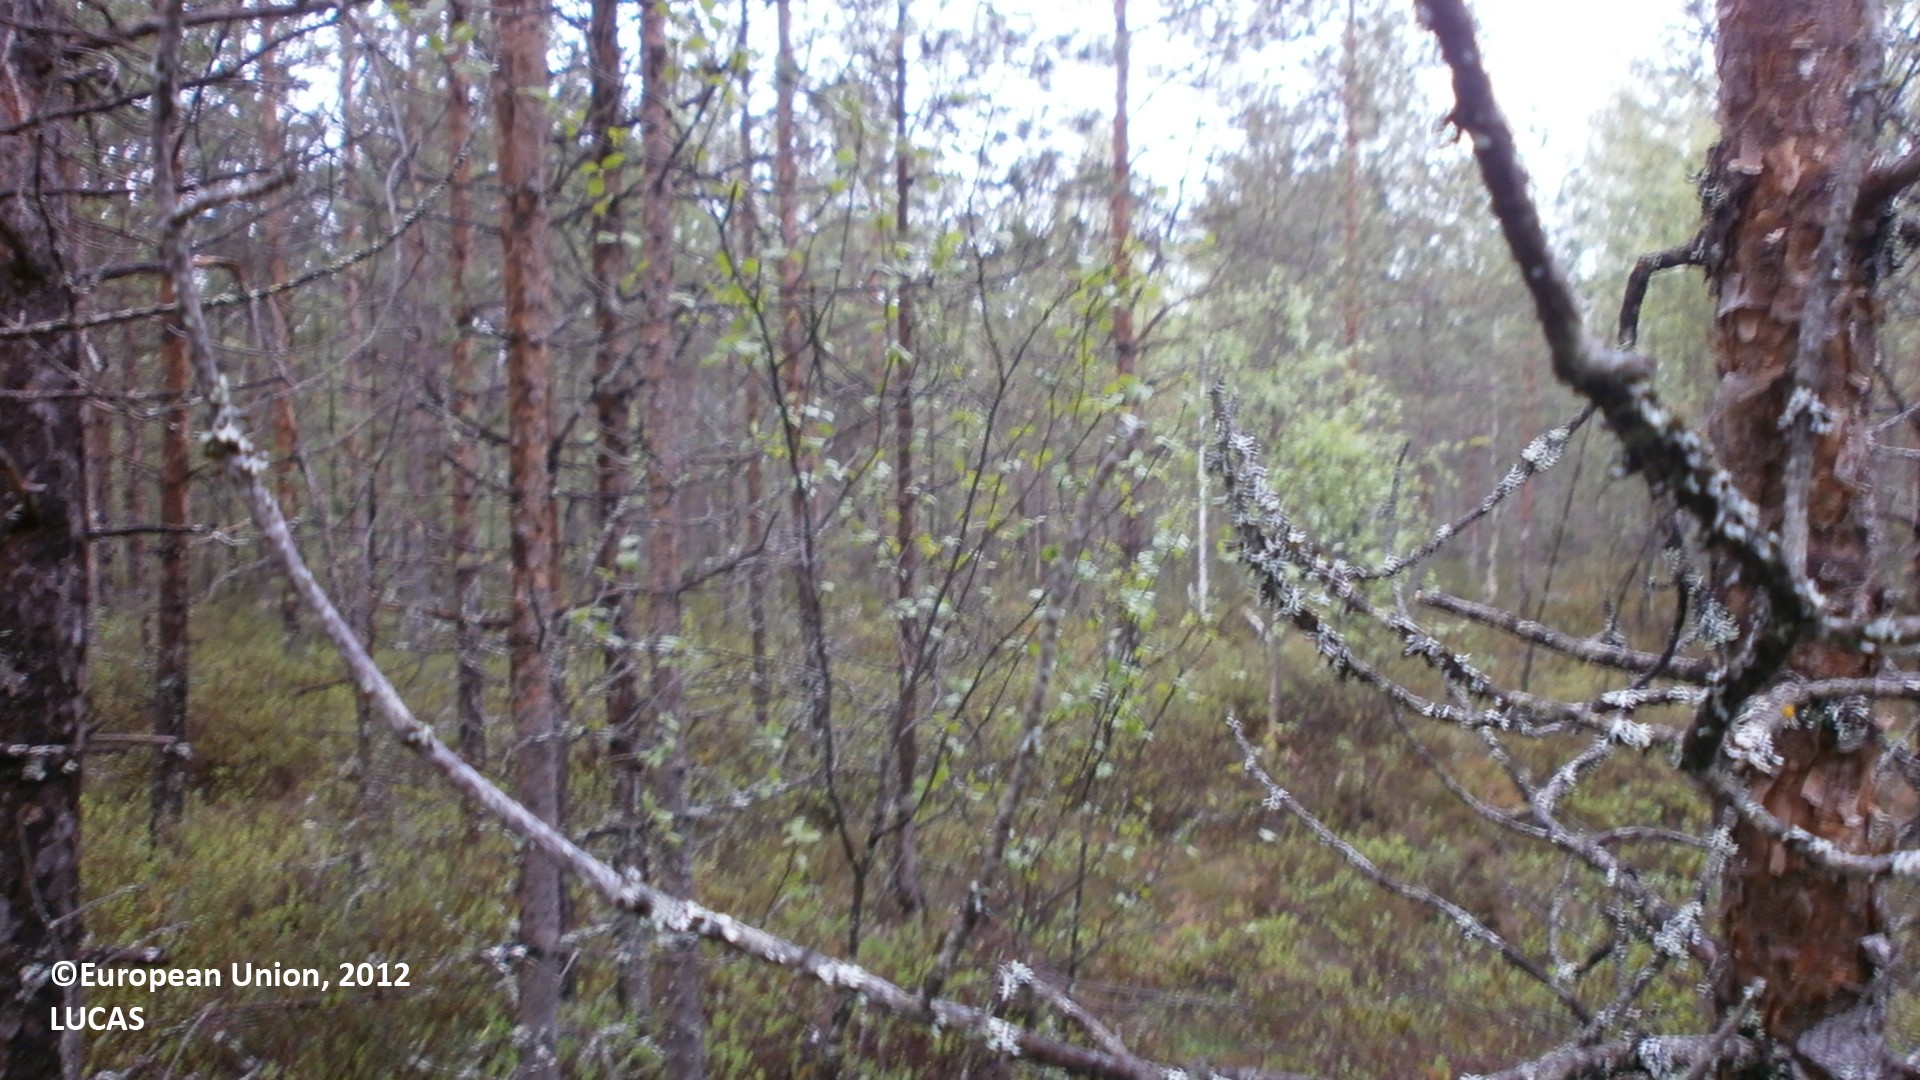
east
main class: Woodland
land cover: Pine dominated coniferous woodland
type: mire and swamp forests
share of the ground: 50 - 75 %
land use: Forestry
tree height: > 5 m
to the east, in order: Pine dominated coniferous woodland; Ditches and canals; Pine dominated coniferous woodland; Ditches and canals; Pine dominated coniferous woodland; Ditches and canals; Other mixed woodland; Ditches and canals; Other mixed woodland; Tracks; Other mixed woodland; Ditches and canals; Paved roads, cycling and walking lanes; Ditches and canals; Broadleaved woodland; Other mixed woodland
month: June
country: FI
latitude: 64.0877
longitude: 26.0863
